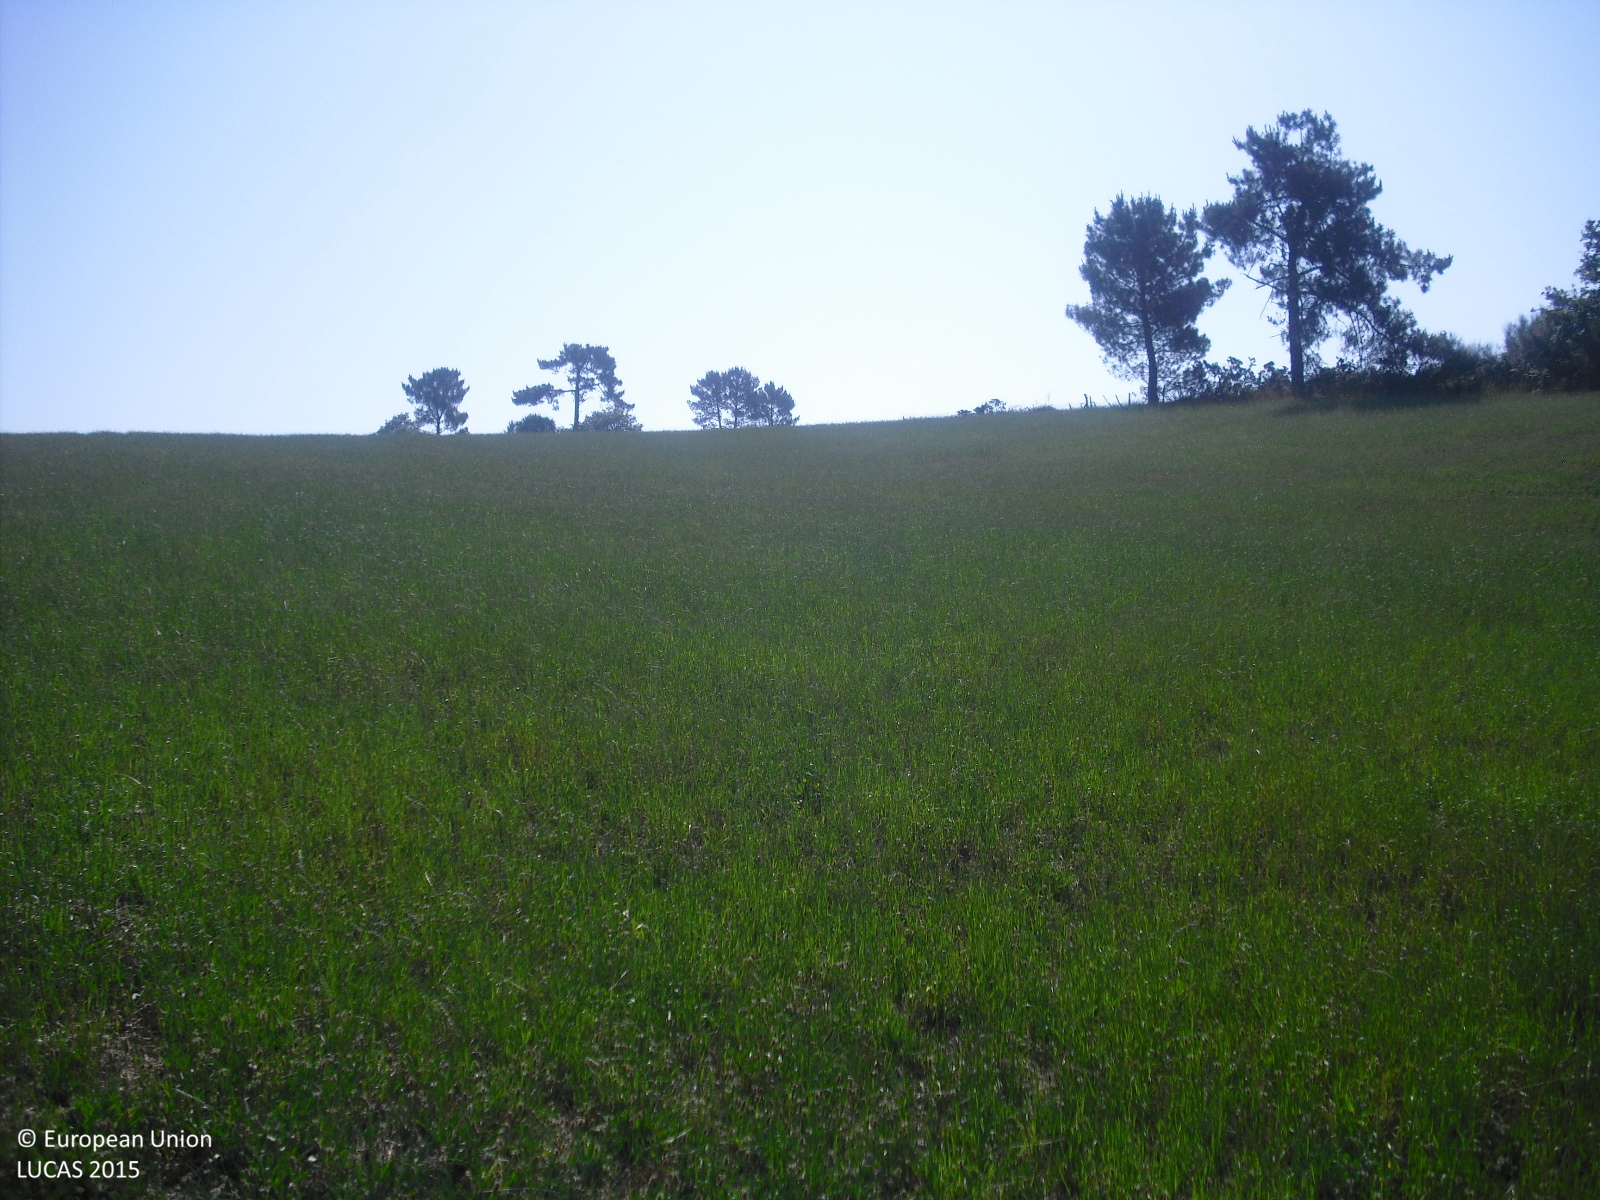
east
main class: Cropland
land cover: Temporary grasslands
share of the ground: > 75 %
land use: Agriculture (excluding fallow land and kitchen gardens)
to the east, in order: Temporary grasslands; Dry stone walls; Fences; Shruby margins; Tracks; Temporary grasslands; Shruby margins; Temporary grasslands; Shruby margins; Temporary grasslands
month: June
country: ES
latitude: 42.5476
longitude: -7.7465
